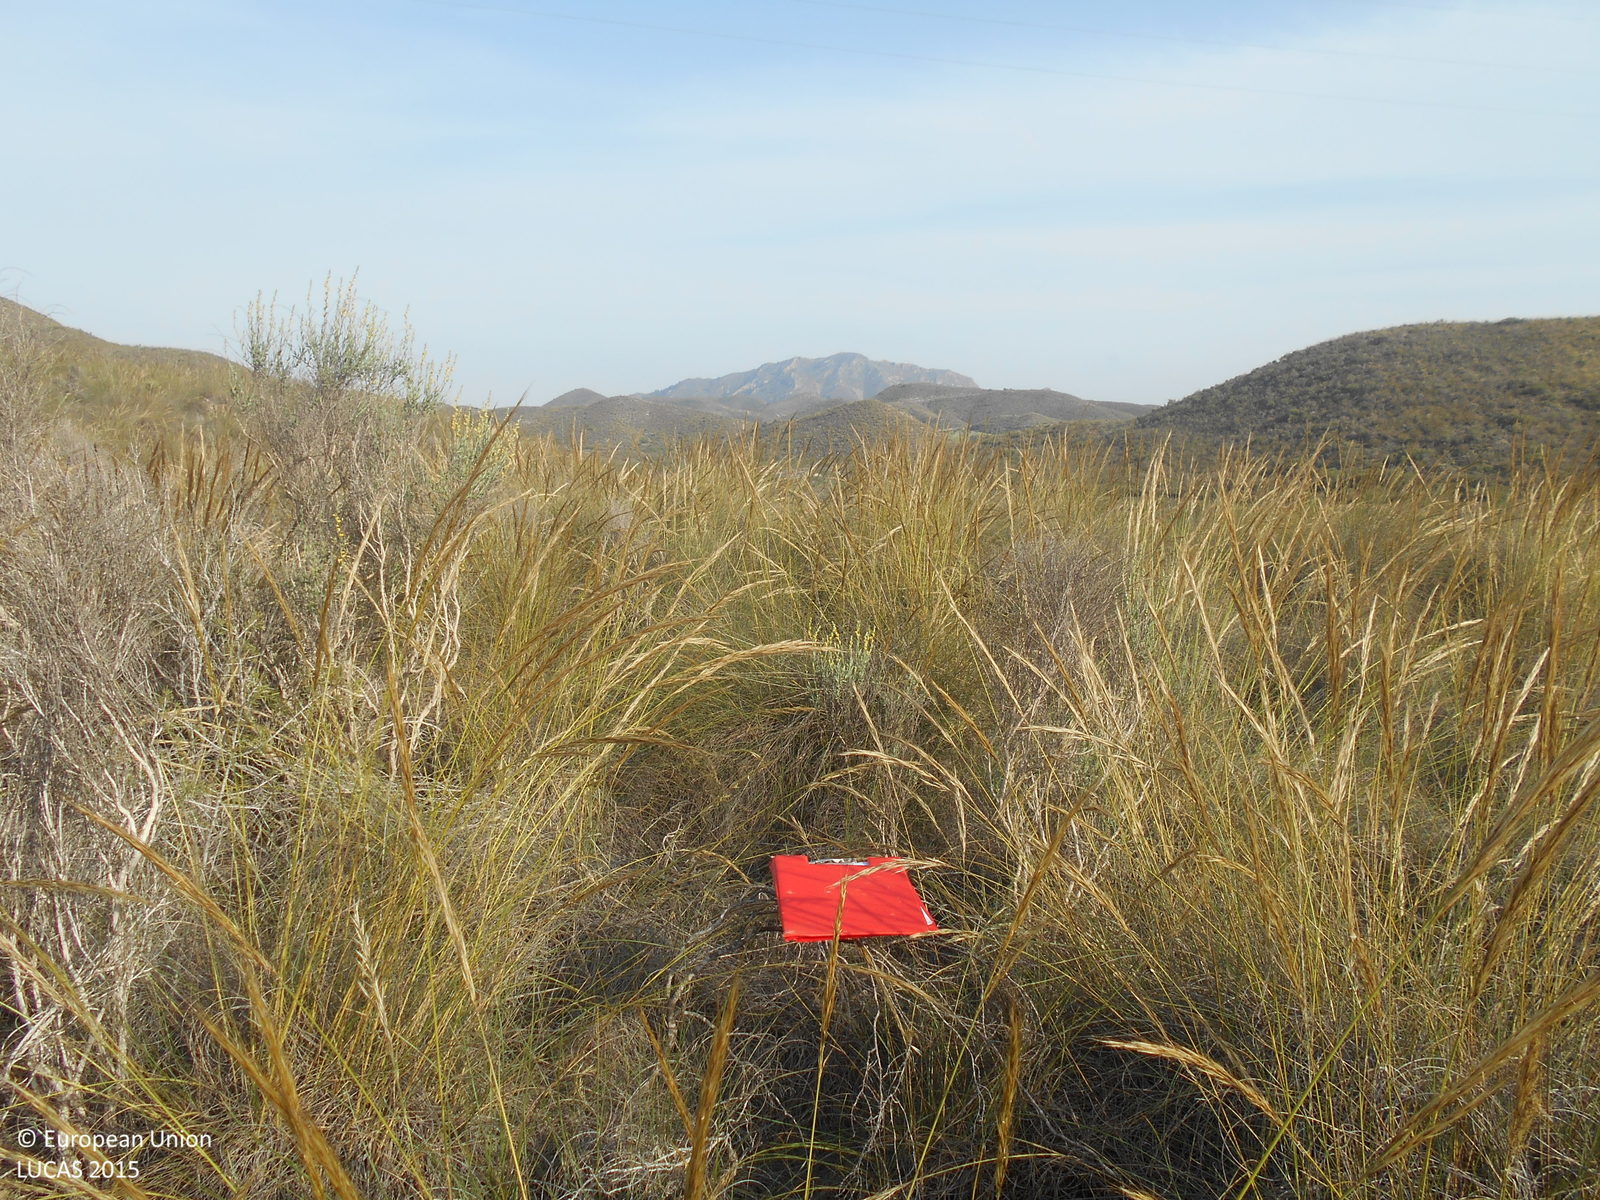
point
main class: Shrubland
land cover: Shrubland without tree cover
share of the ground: > 75 %
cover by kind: shrubs 95 %, unconsolidated bare surface 5 %
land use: Semi-natural and natural areas not in use
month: April
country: ES
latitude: 37.6746
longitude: -1.3074
